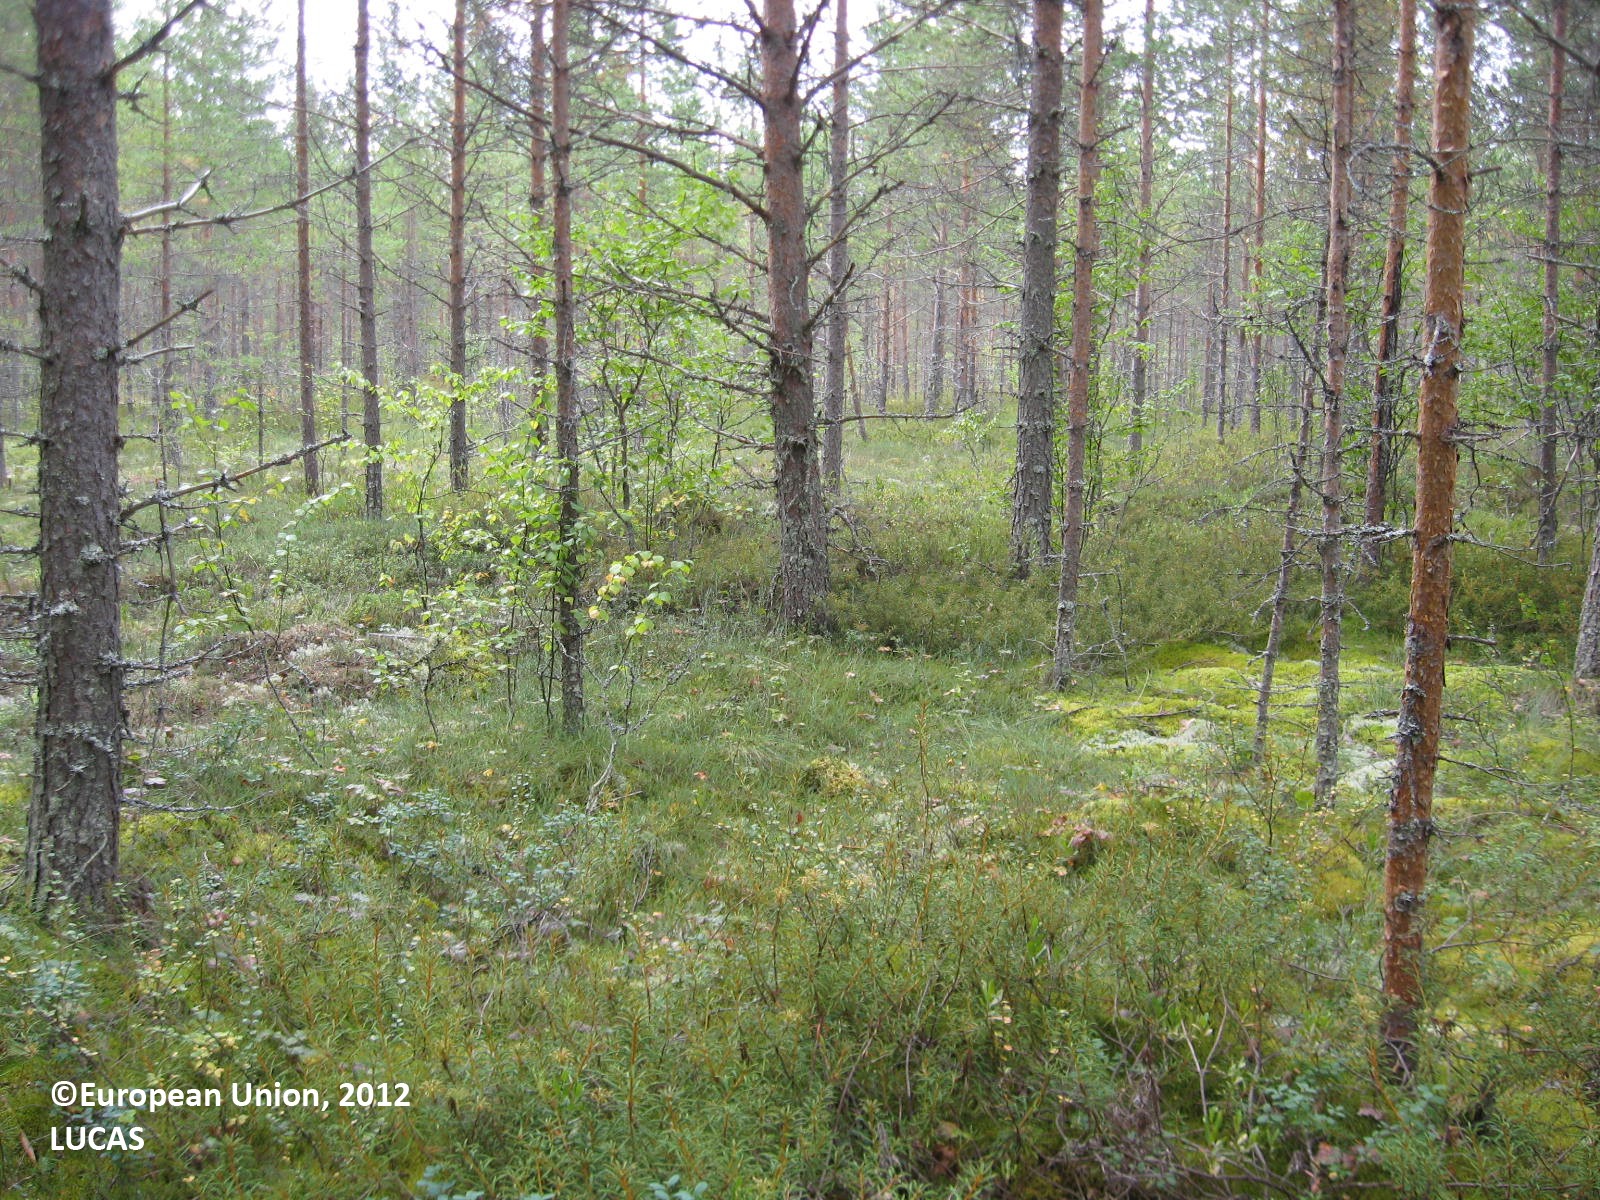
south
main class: Woodland
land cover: Pine dominated coniferous woodland
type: boreal forest
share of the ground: > 75 %
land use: Forestry
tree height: > 5 m
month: August
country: FI
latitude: 63.4472
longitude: 30.0824
